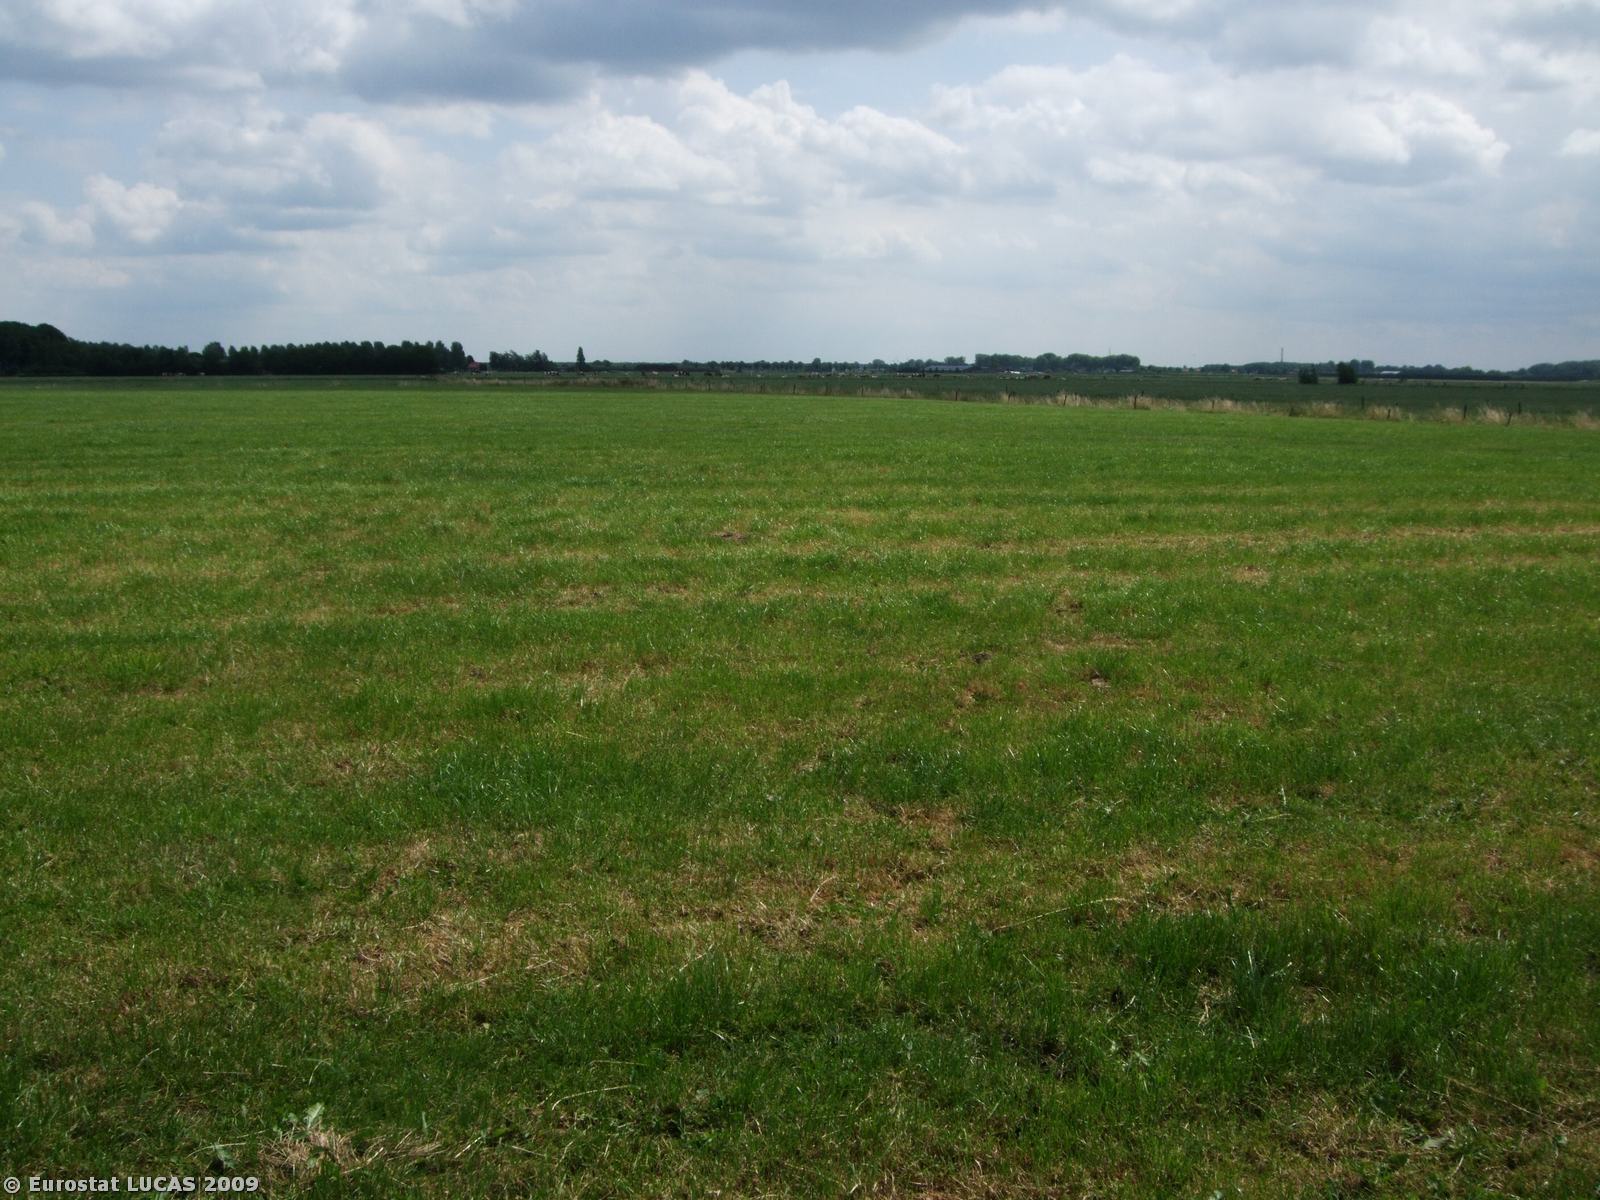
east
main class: Grassland
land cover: Grassland without tree/shrub cover
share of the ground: > 75 %
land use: Agriculture (excluding fallow land and kitchen gardens)
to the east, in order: Grassland without tree/shrub cover; Fences; Ditches and canals; Fences; Grassland without tree/shrub cover; Fences; Ditches and canals; Fences; Tracks; Fences; Grassland without tree/shrub cover
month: July
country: NL
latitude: 51.9267
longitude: 5.3591
